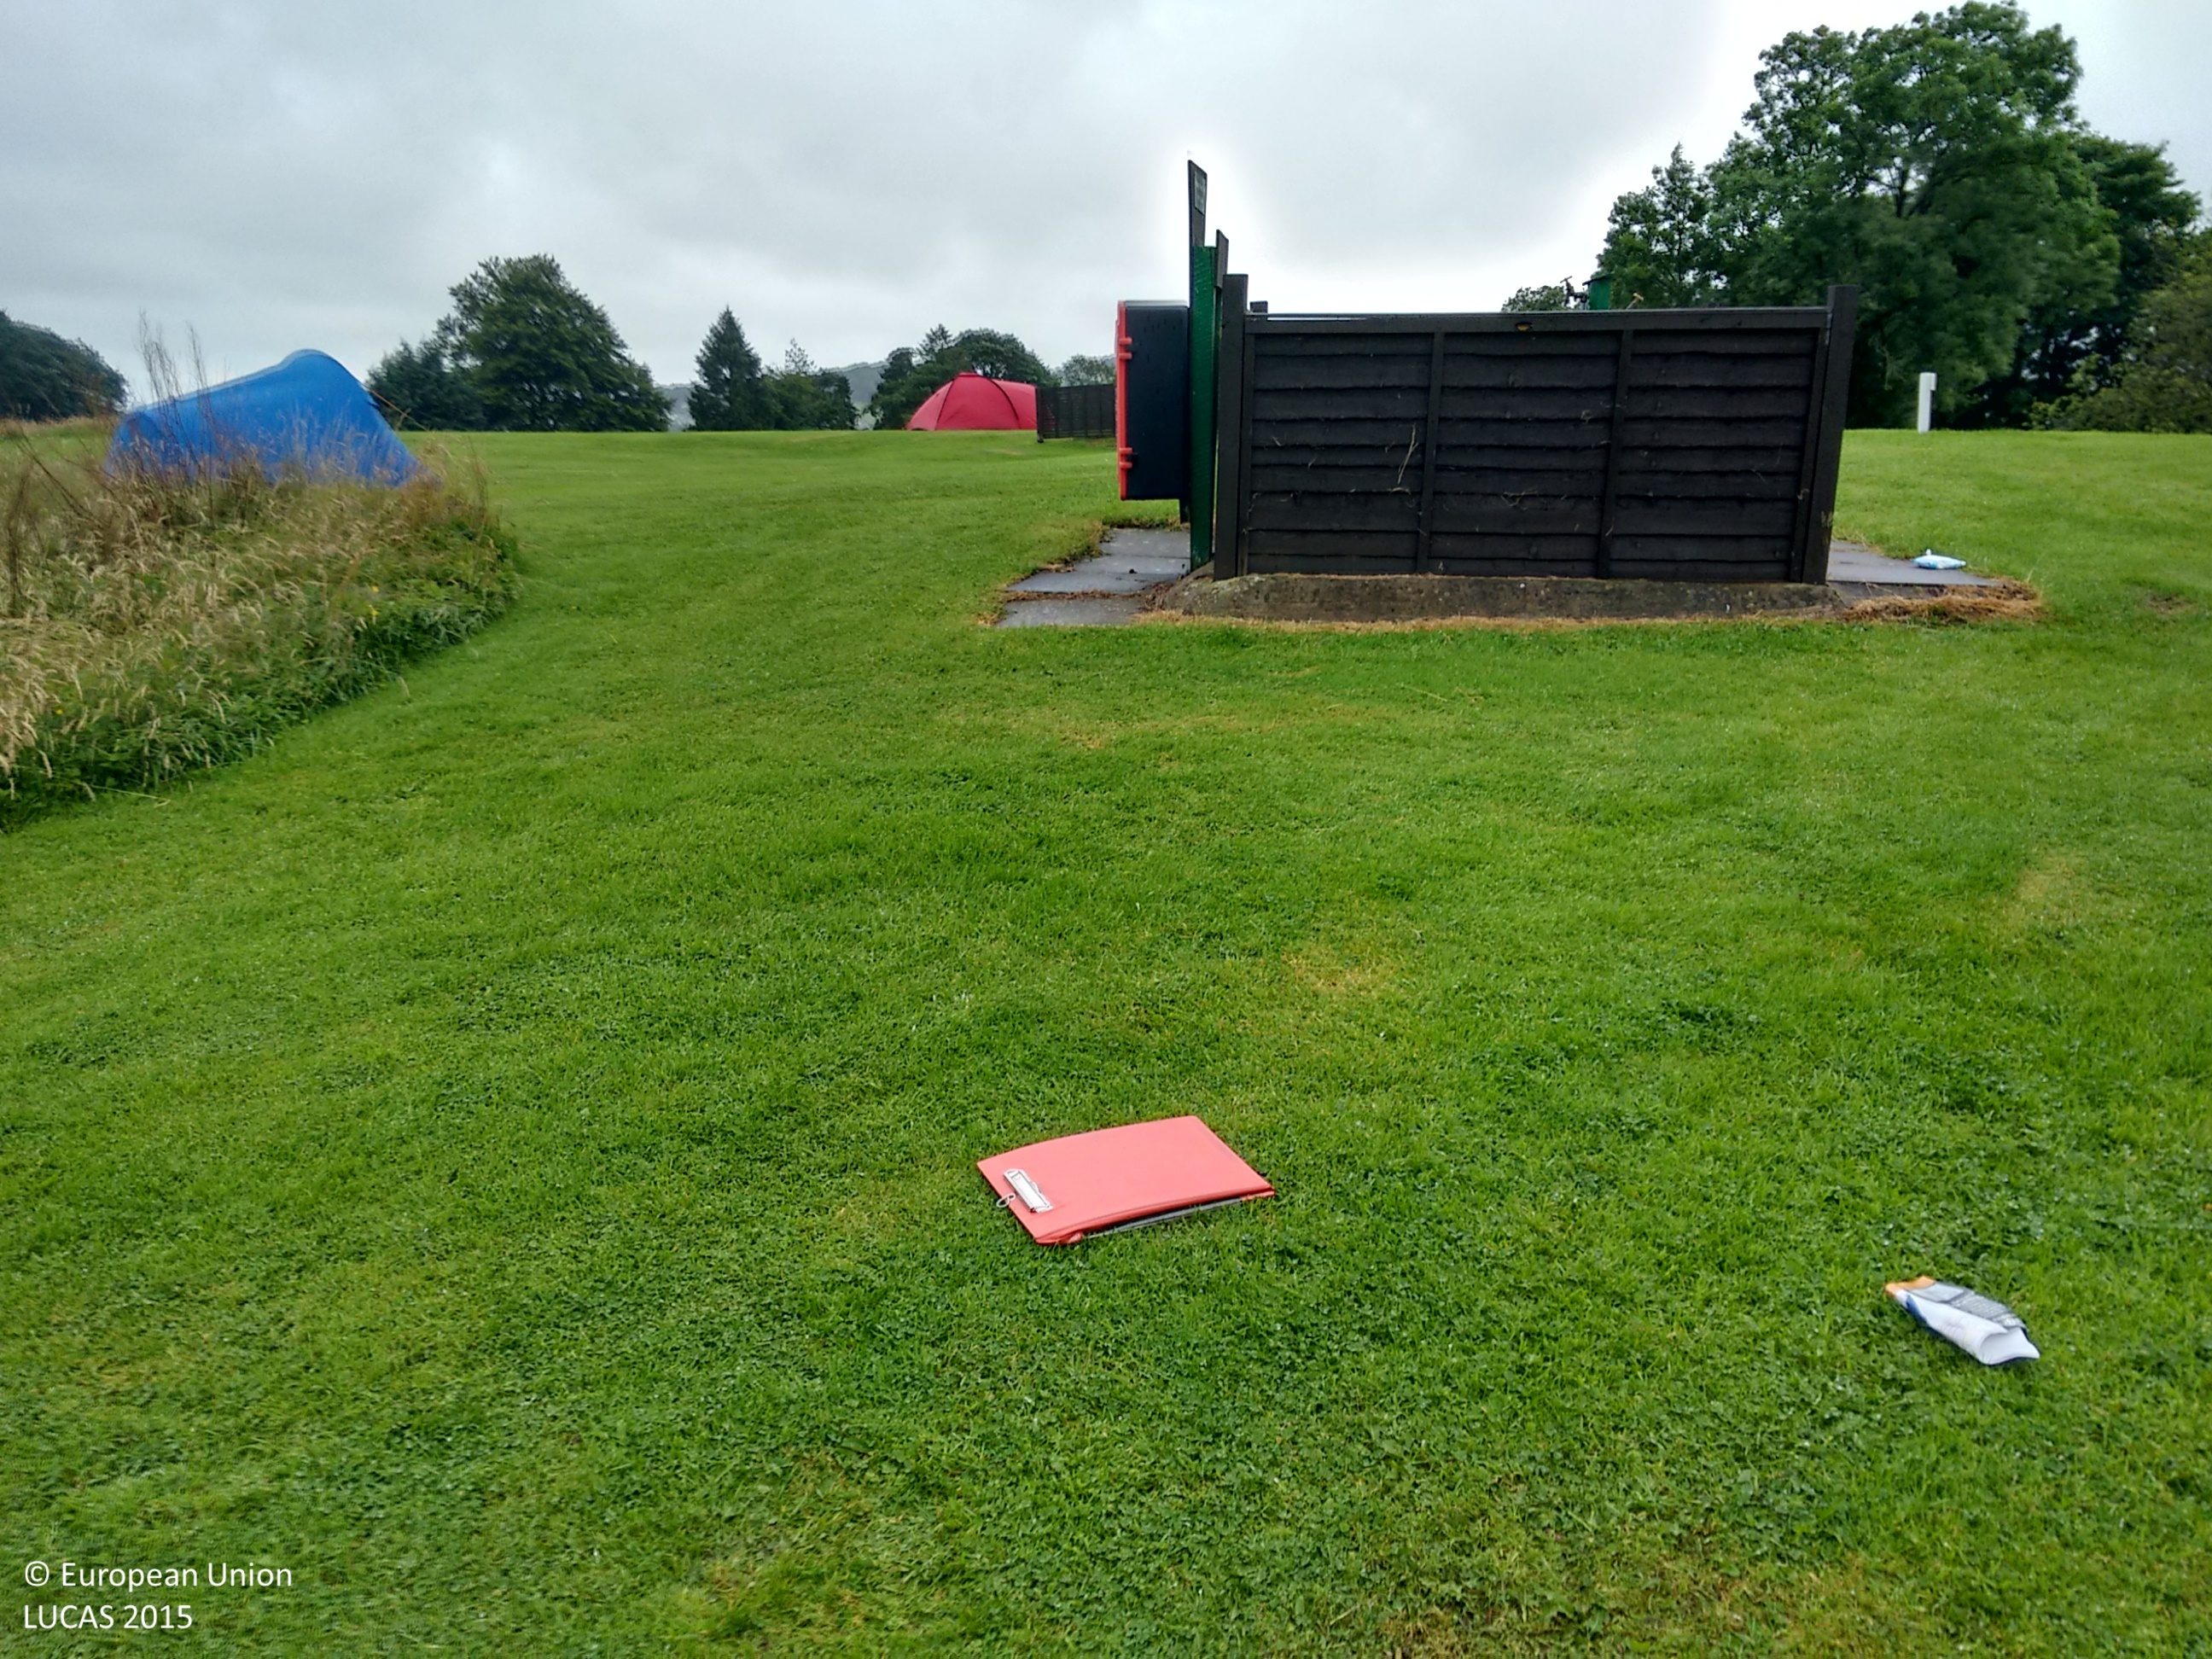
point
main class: Grassland
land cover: Grassland without tree/shrub cover
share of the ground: > 75 %
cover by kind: herbaceous plants 100 %
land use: Amenities, museums, leisure
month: August
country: GB
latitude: 54.3478
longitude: -2.7292
